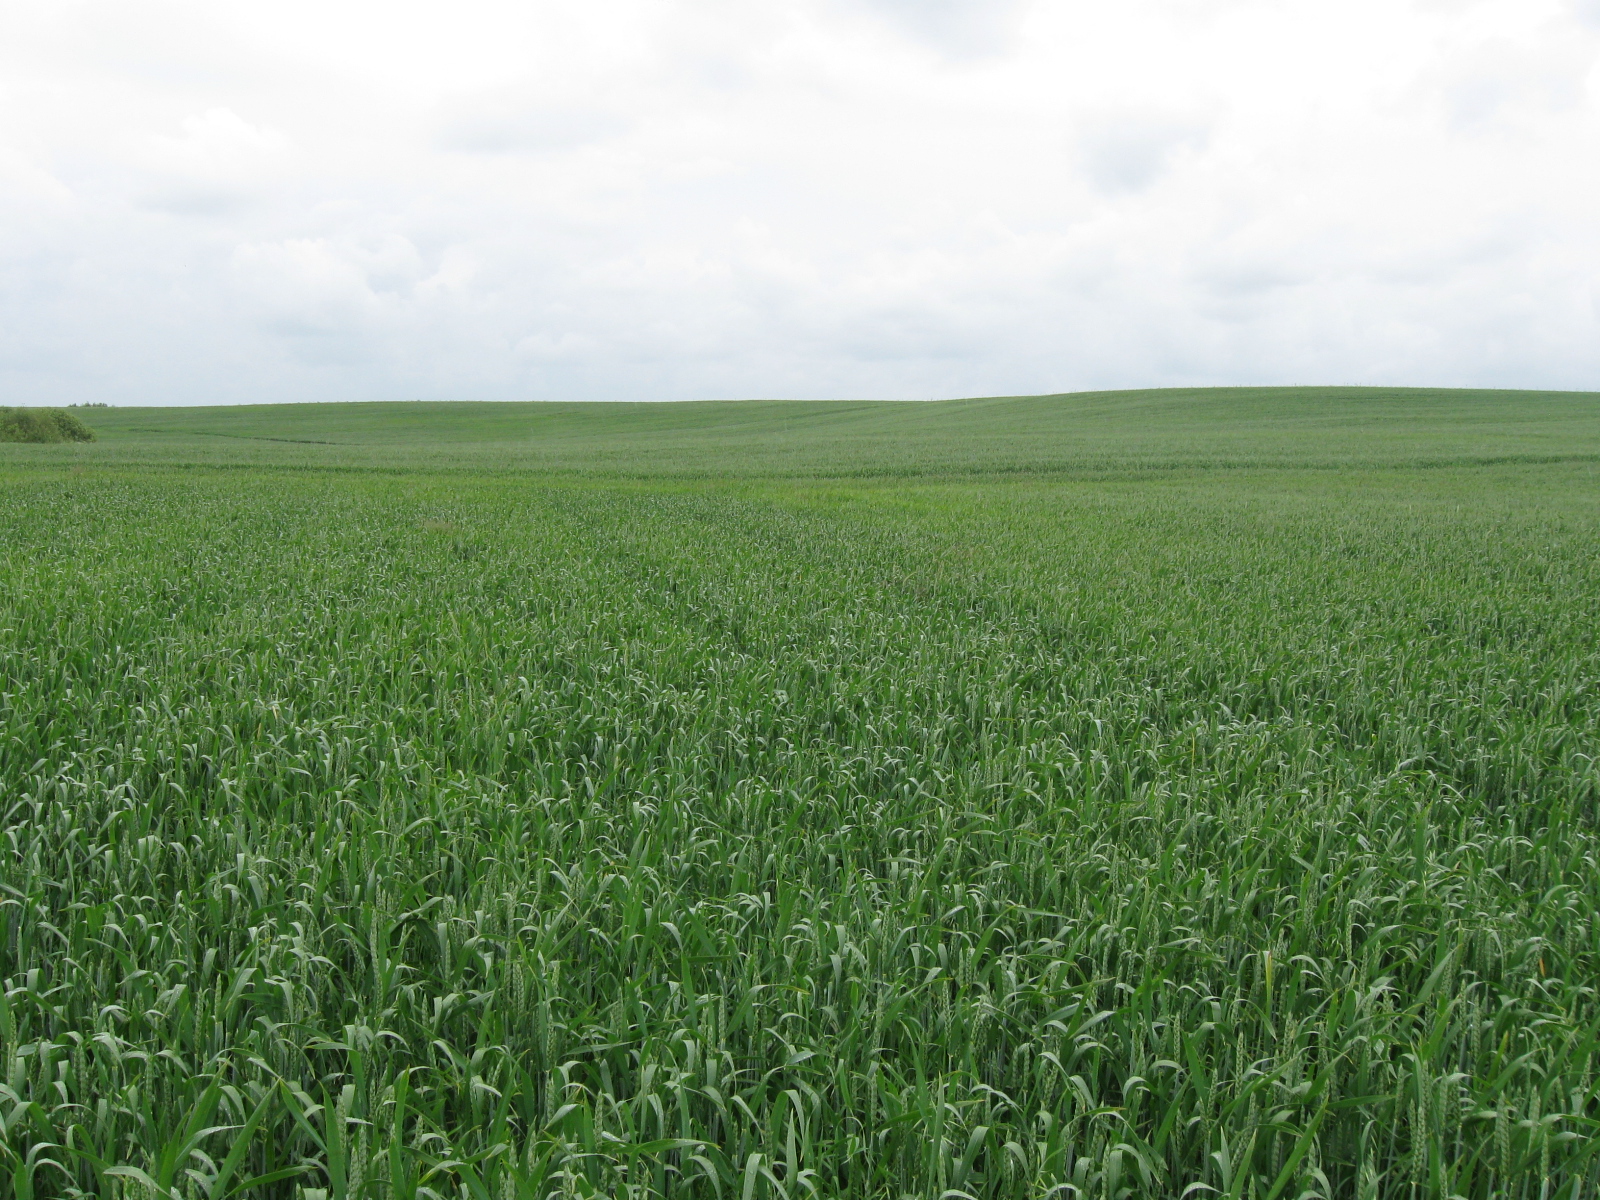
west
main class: Cropland
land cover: Common wheat
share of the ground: > 75 %
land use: Agriculture (excluding fallow land and kitchen gardens)
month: June
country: LT
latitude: 54.9113
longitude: 24.5633
